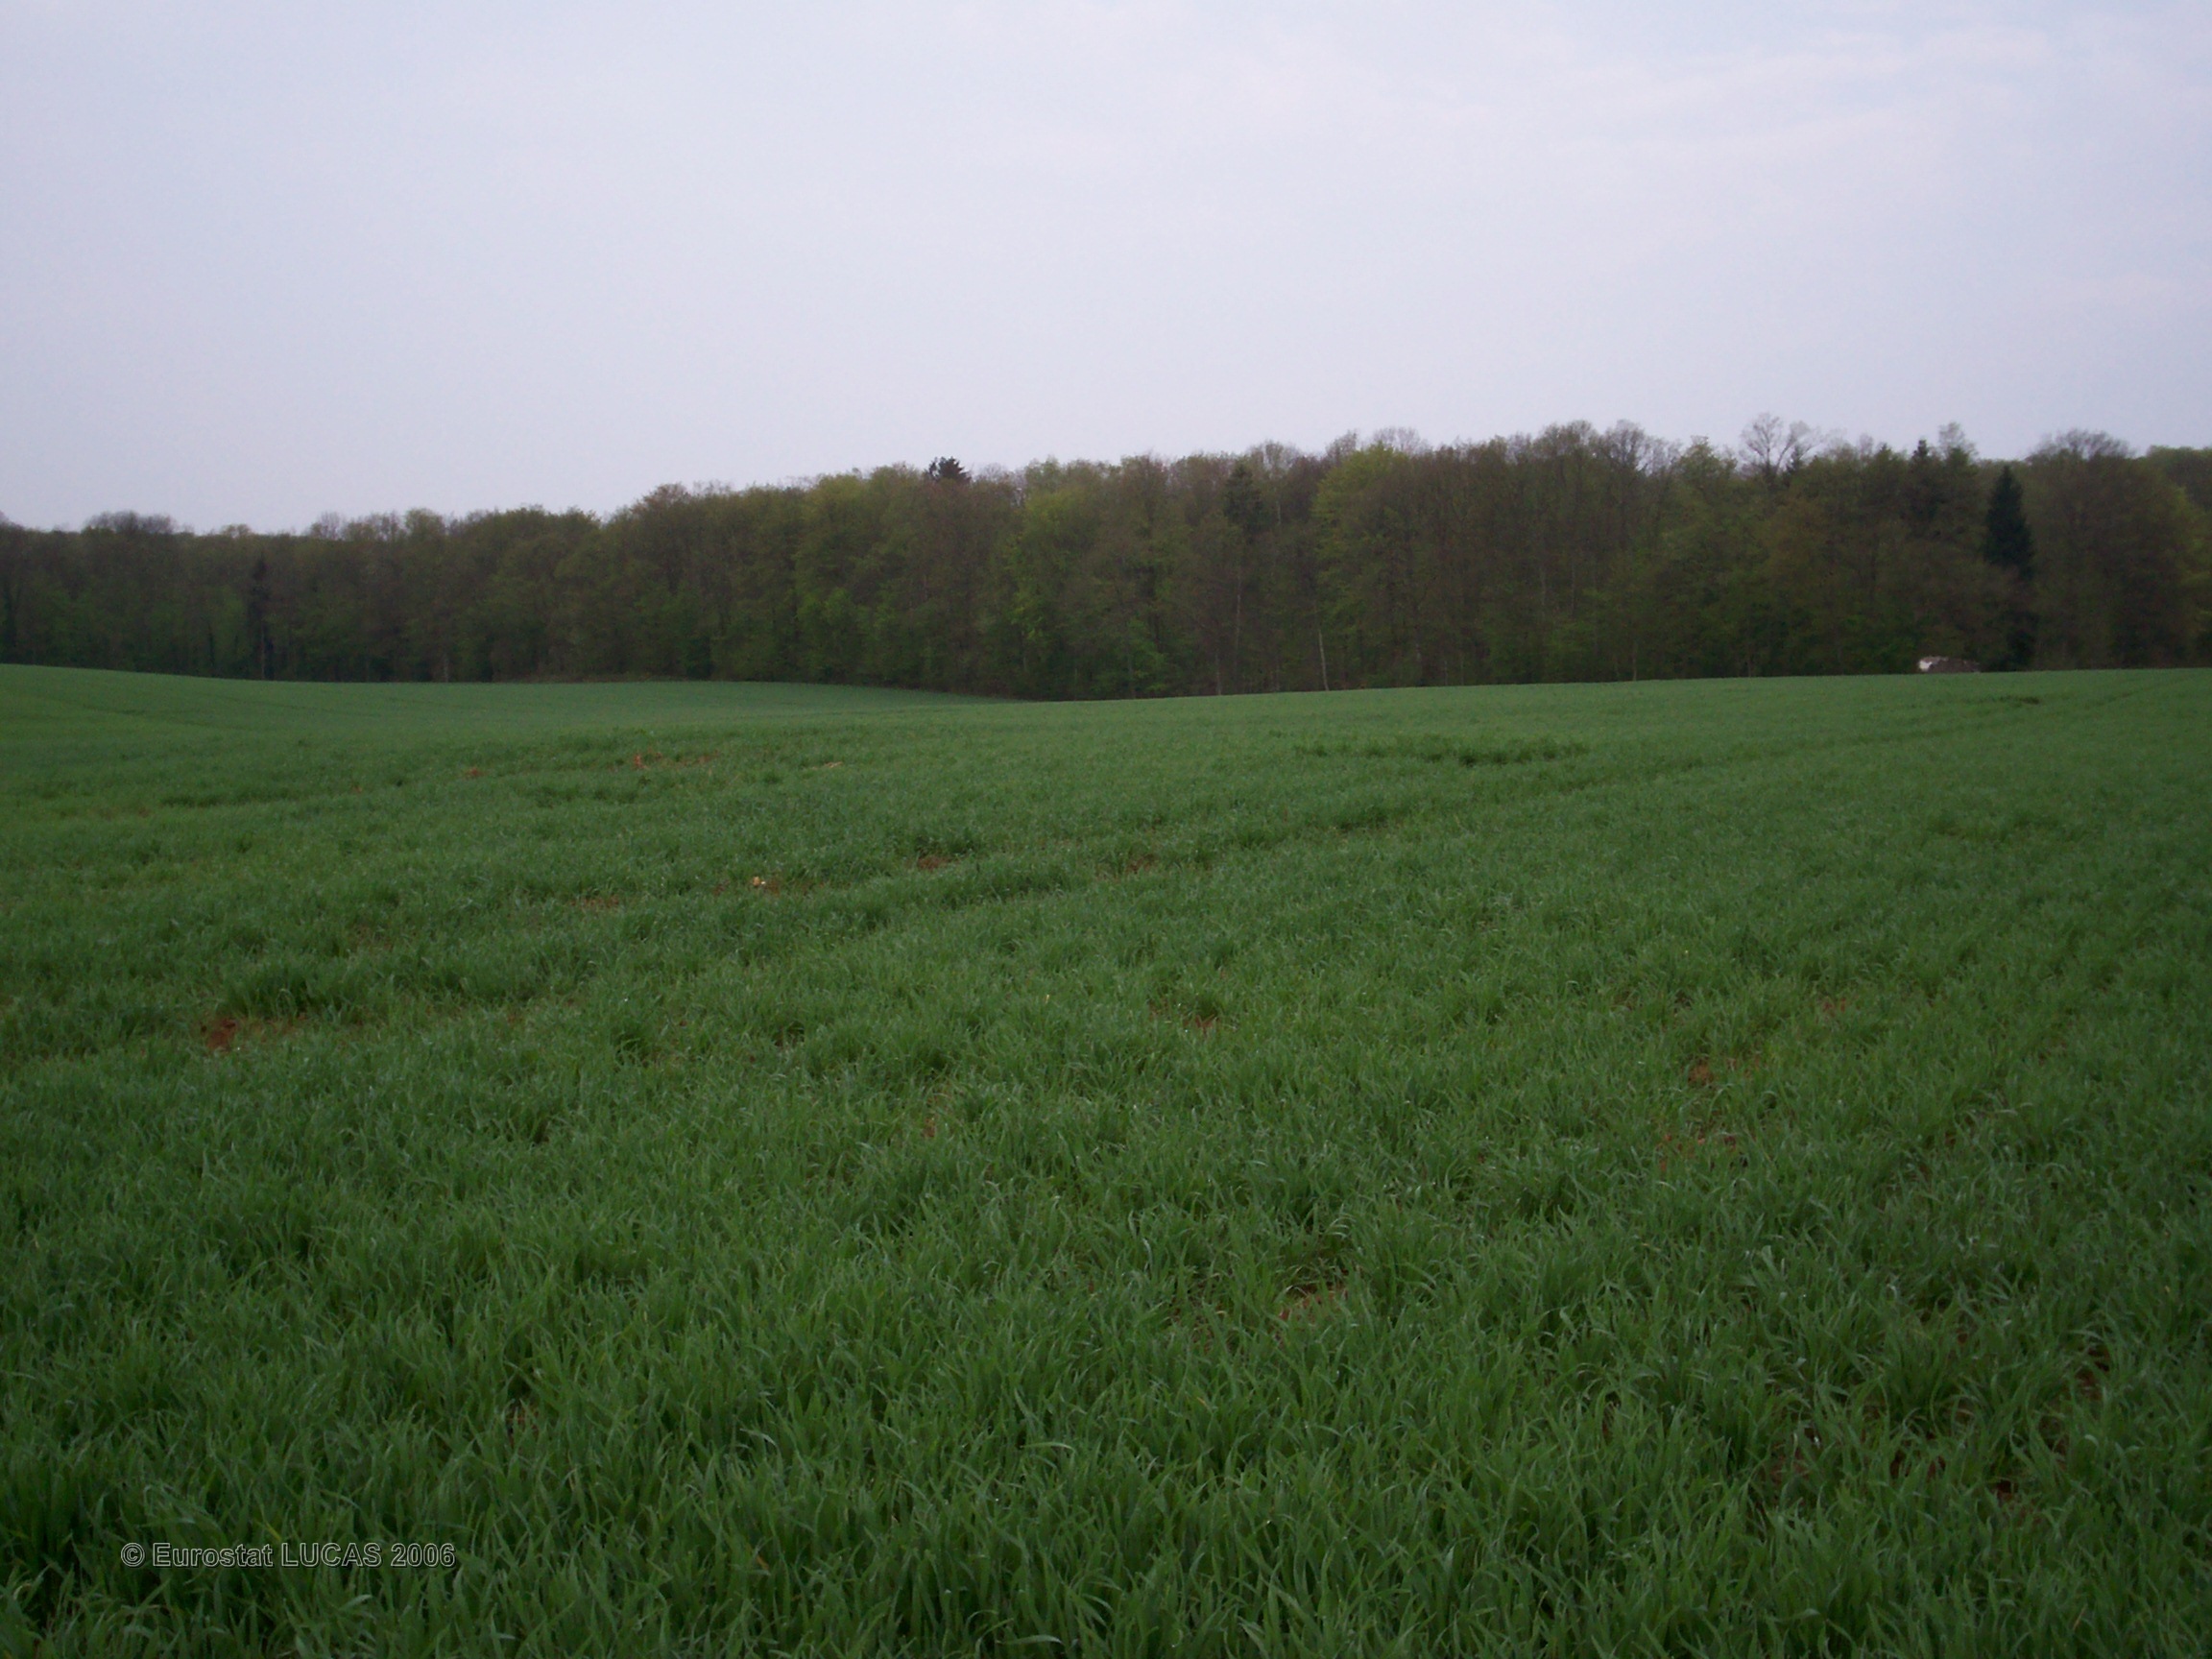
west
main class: Cropland
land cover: Common wheat
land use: Agriculture (excluding fallow land and kitchen gardens)
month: April
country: FR
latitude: 47.5054
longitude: 6.0848
